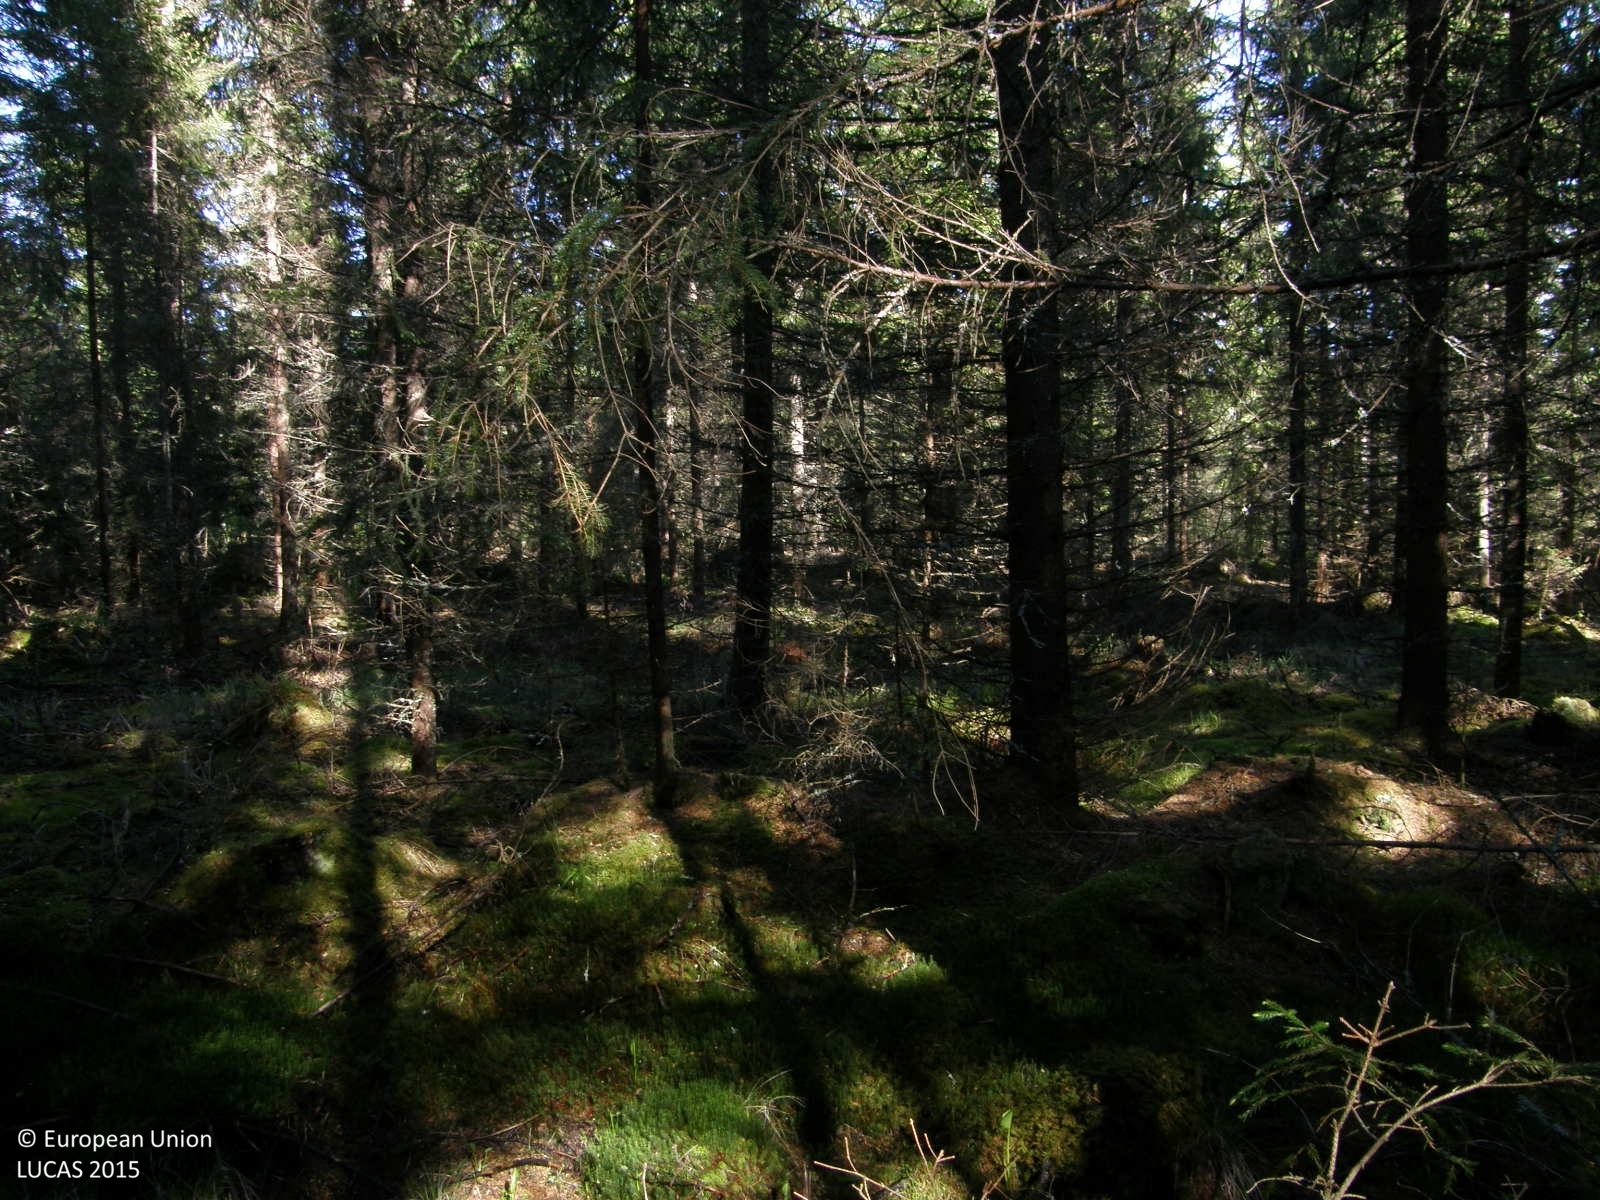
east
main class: Woodland
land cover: Spruce dominated coniferous woodland
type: boreal forest
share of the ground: > 75 %
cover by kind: coniferous forest trees 95 %, lichens and mosses 5 %
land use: Forestry
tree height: > 5 m
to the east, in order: Spruce dominated coniferous woodland; Ditches and canals; Spruce dominated coniferous woodland; Ditches and canals; Spruce dominated coniferous woodland; Ditches and canals; Broadleaved woodland; Ditches and canals; Broadleaved woodland; Ditches and canals; Other coniferous woodland; Spruce dominated coniferous woodland; Electric lines; Pine dominated coniferous woodland
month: June
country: FI
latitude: 61.9539
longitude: 21.6983
